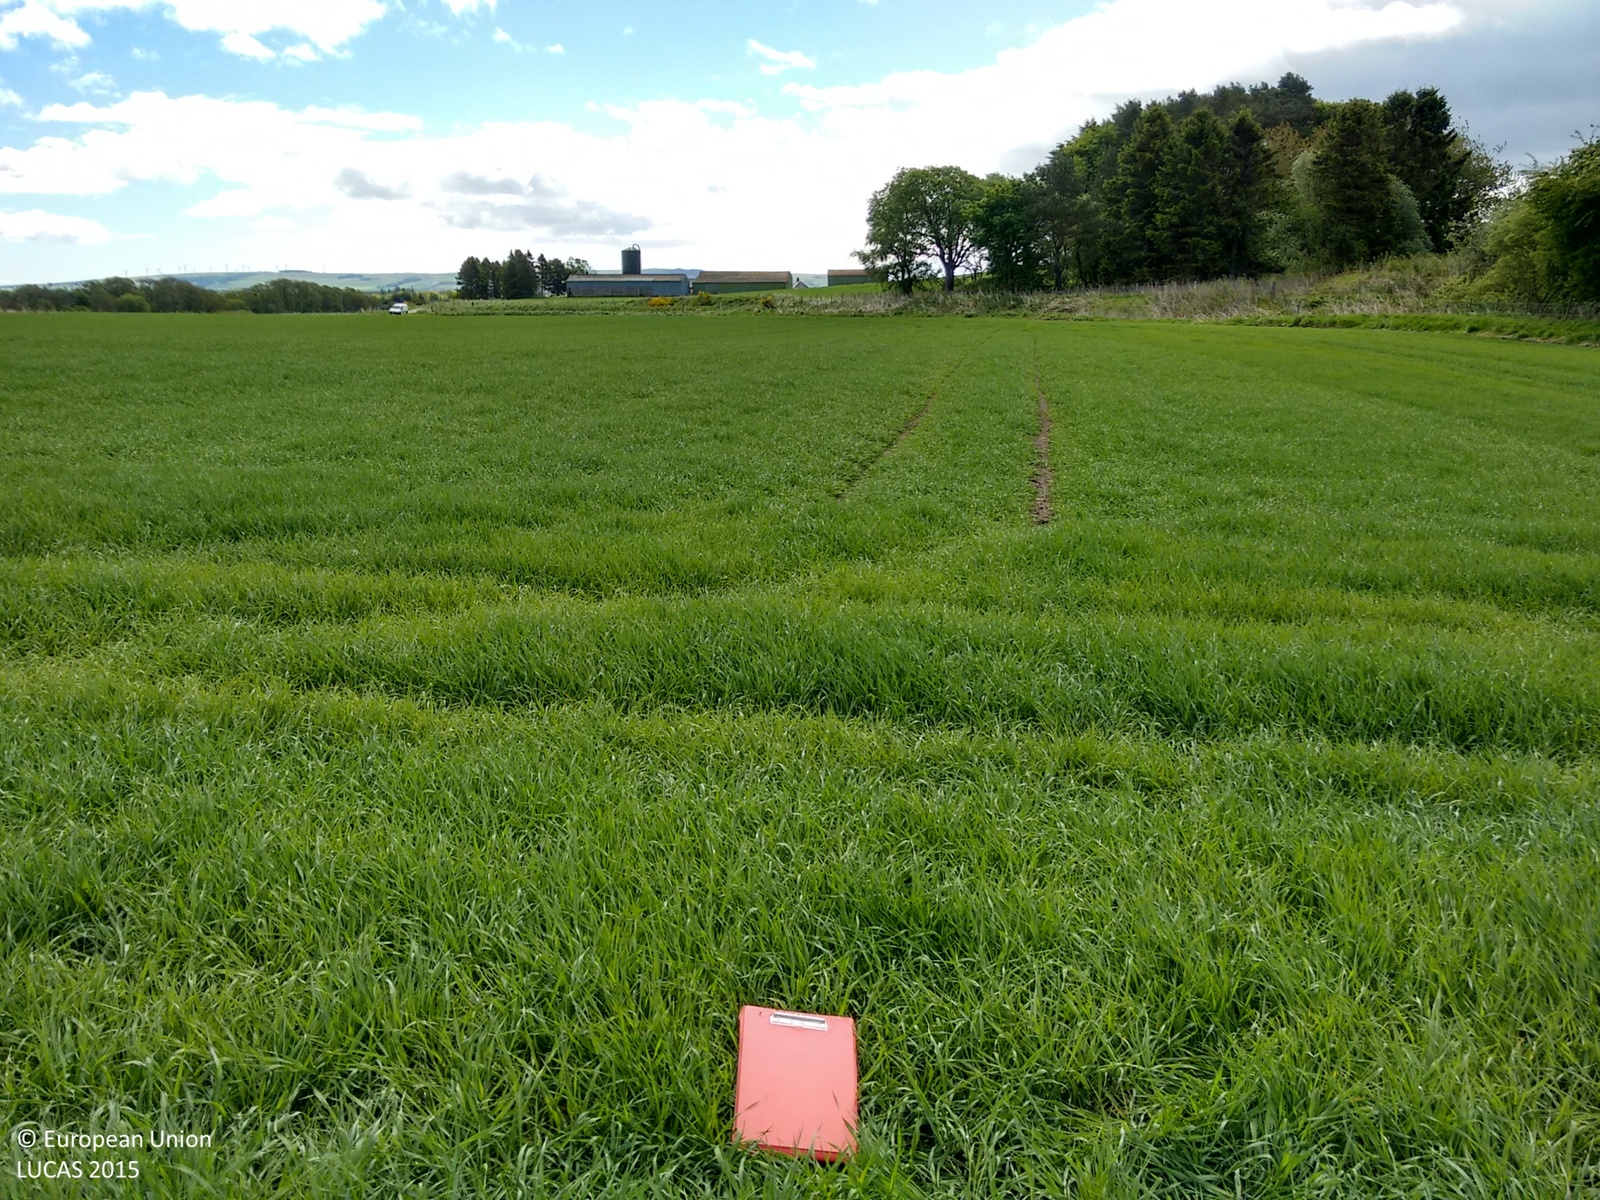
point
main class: Cropland
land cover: Barley
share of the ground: > 75 %
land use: Agriculture (excluding fallow land and kitchen gardens)
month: June
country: GB
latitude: 56.8573
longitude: -2.6034
